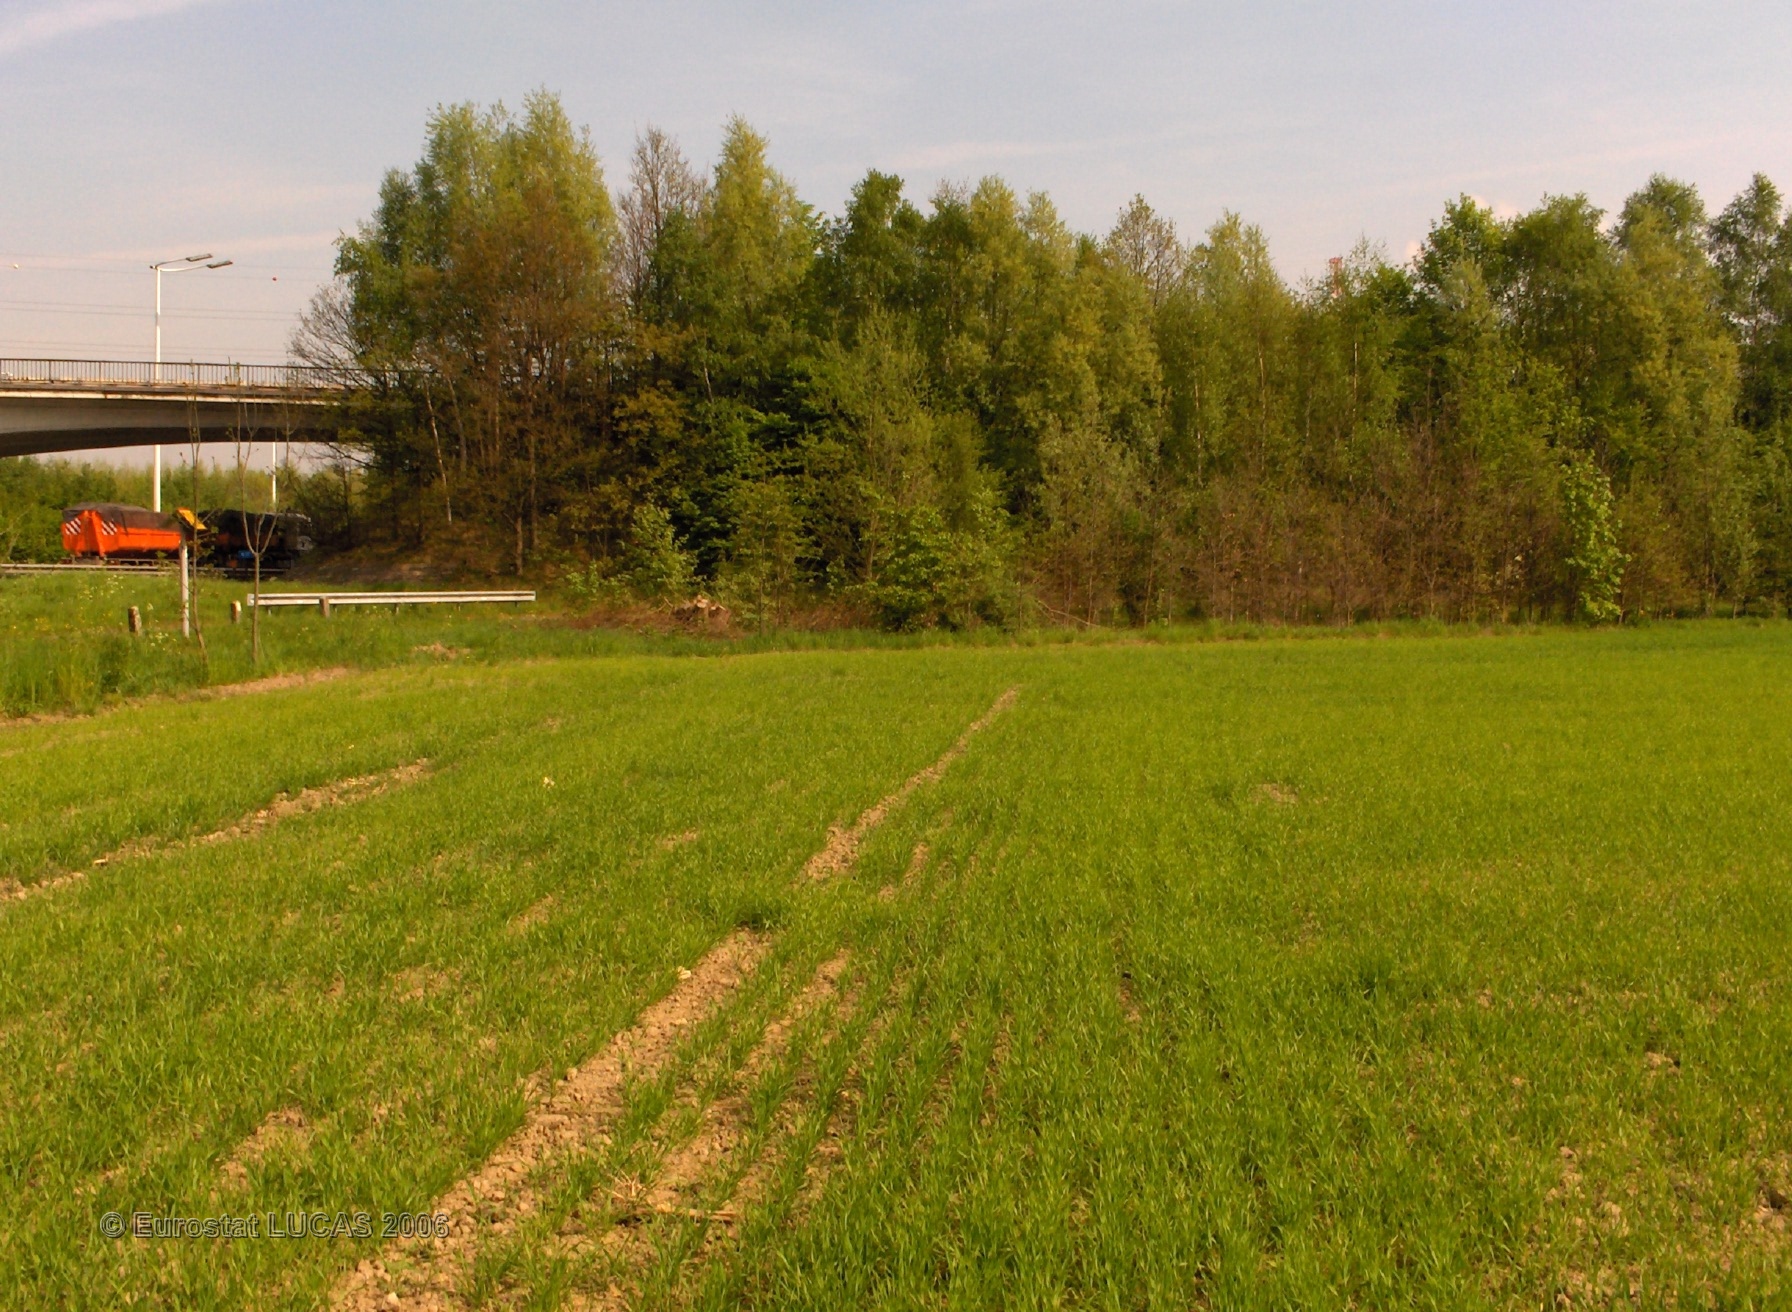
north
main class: Cropland
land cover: Common wheat
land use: Agriculture (excluding fallow land and kitchen gardens)
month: May
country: BE
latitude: 50.9520
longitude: 4.4868
